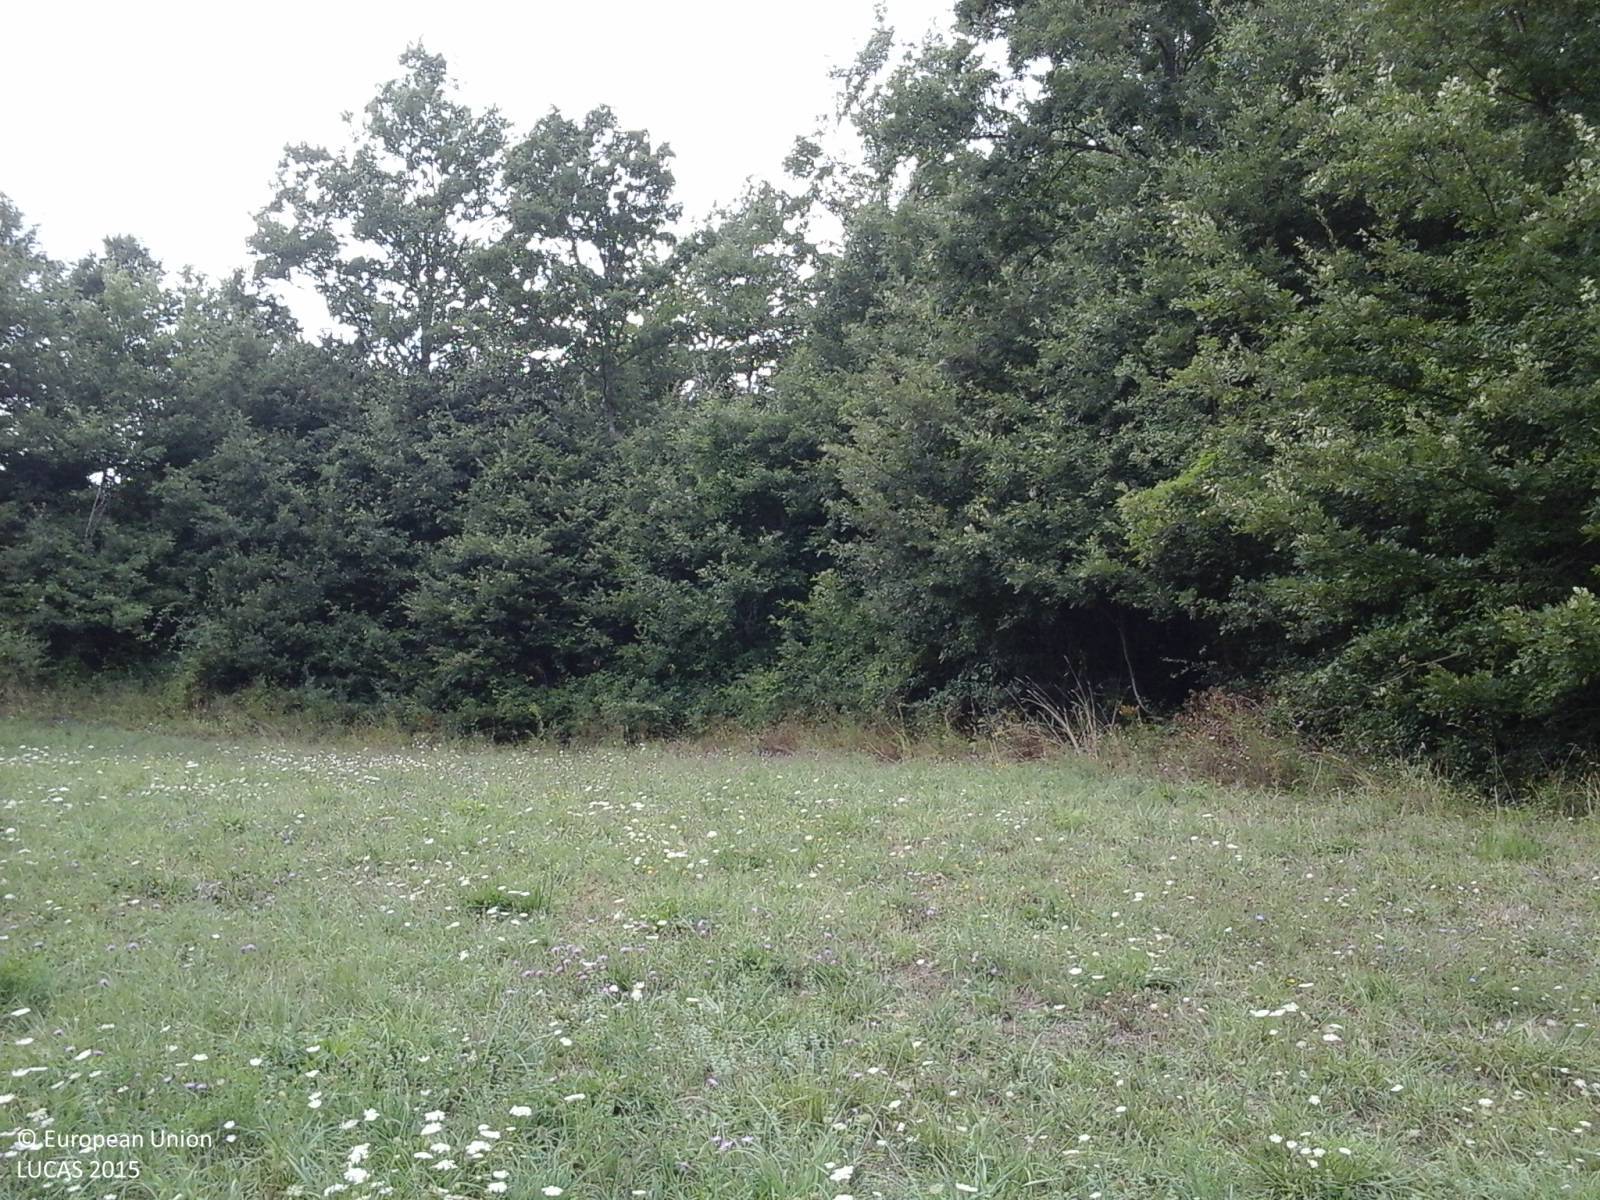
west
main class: Grassland
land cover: Grassland without tree/shrub cover
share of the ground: > 75 %
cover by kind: herbaceous plants 100 %
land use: Agriculture (excluding fallow land and kitchen gardens)
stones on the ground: < 10 %
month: August
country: IT
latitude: 43.7154
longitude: 12.1170
